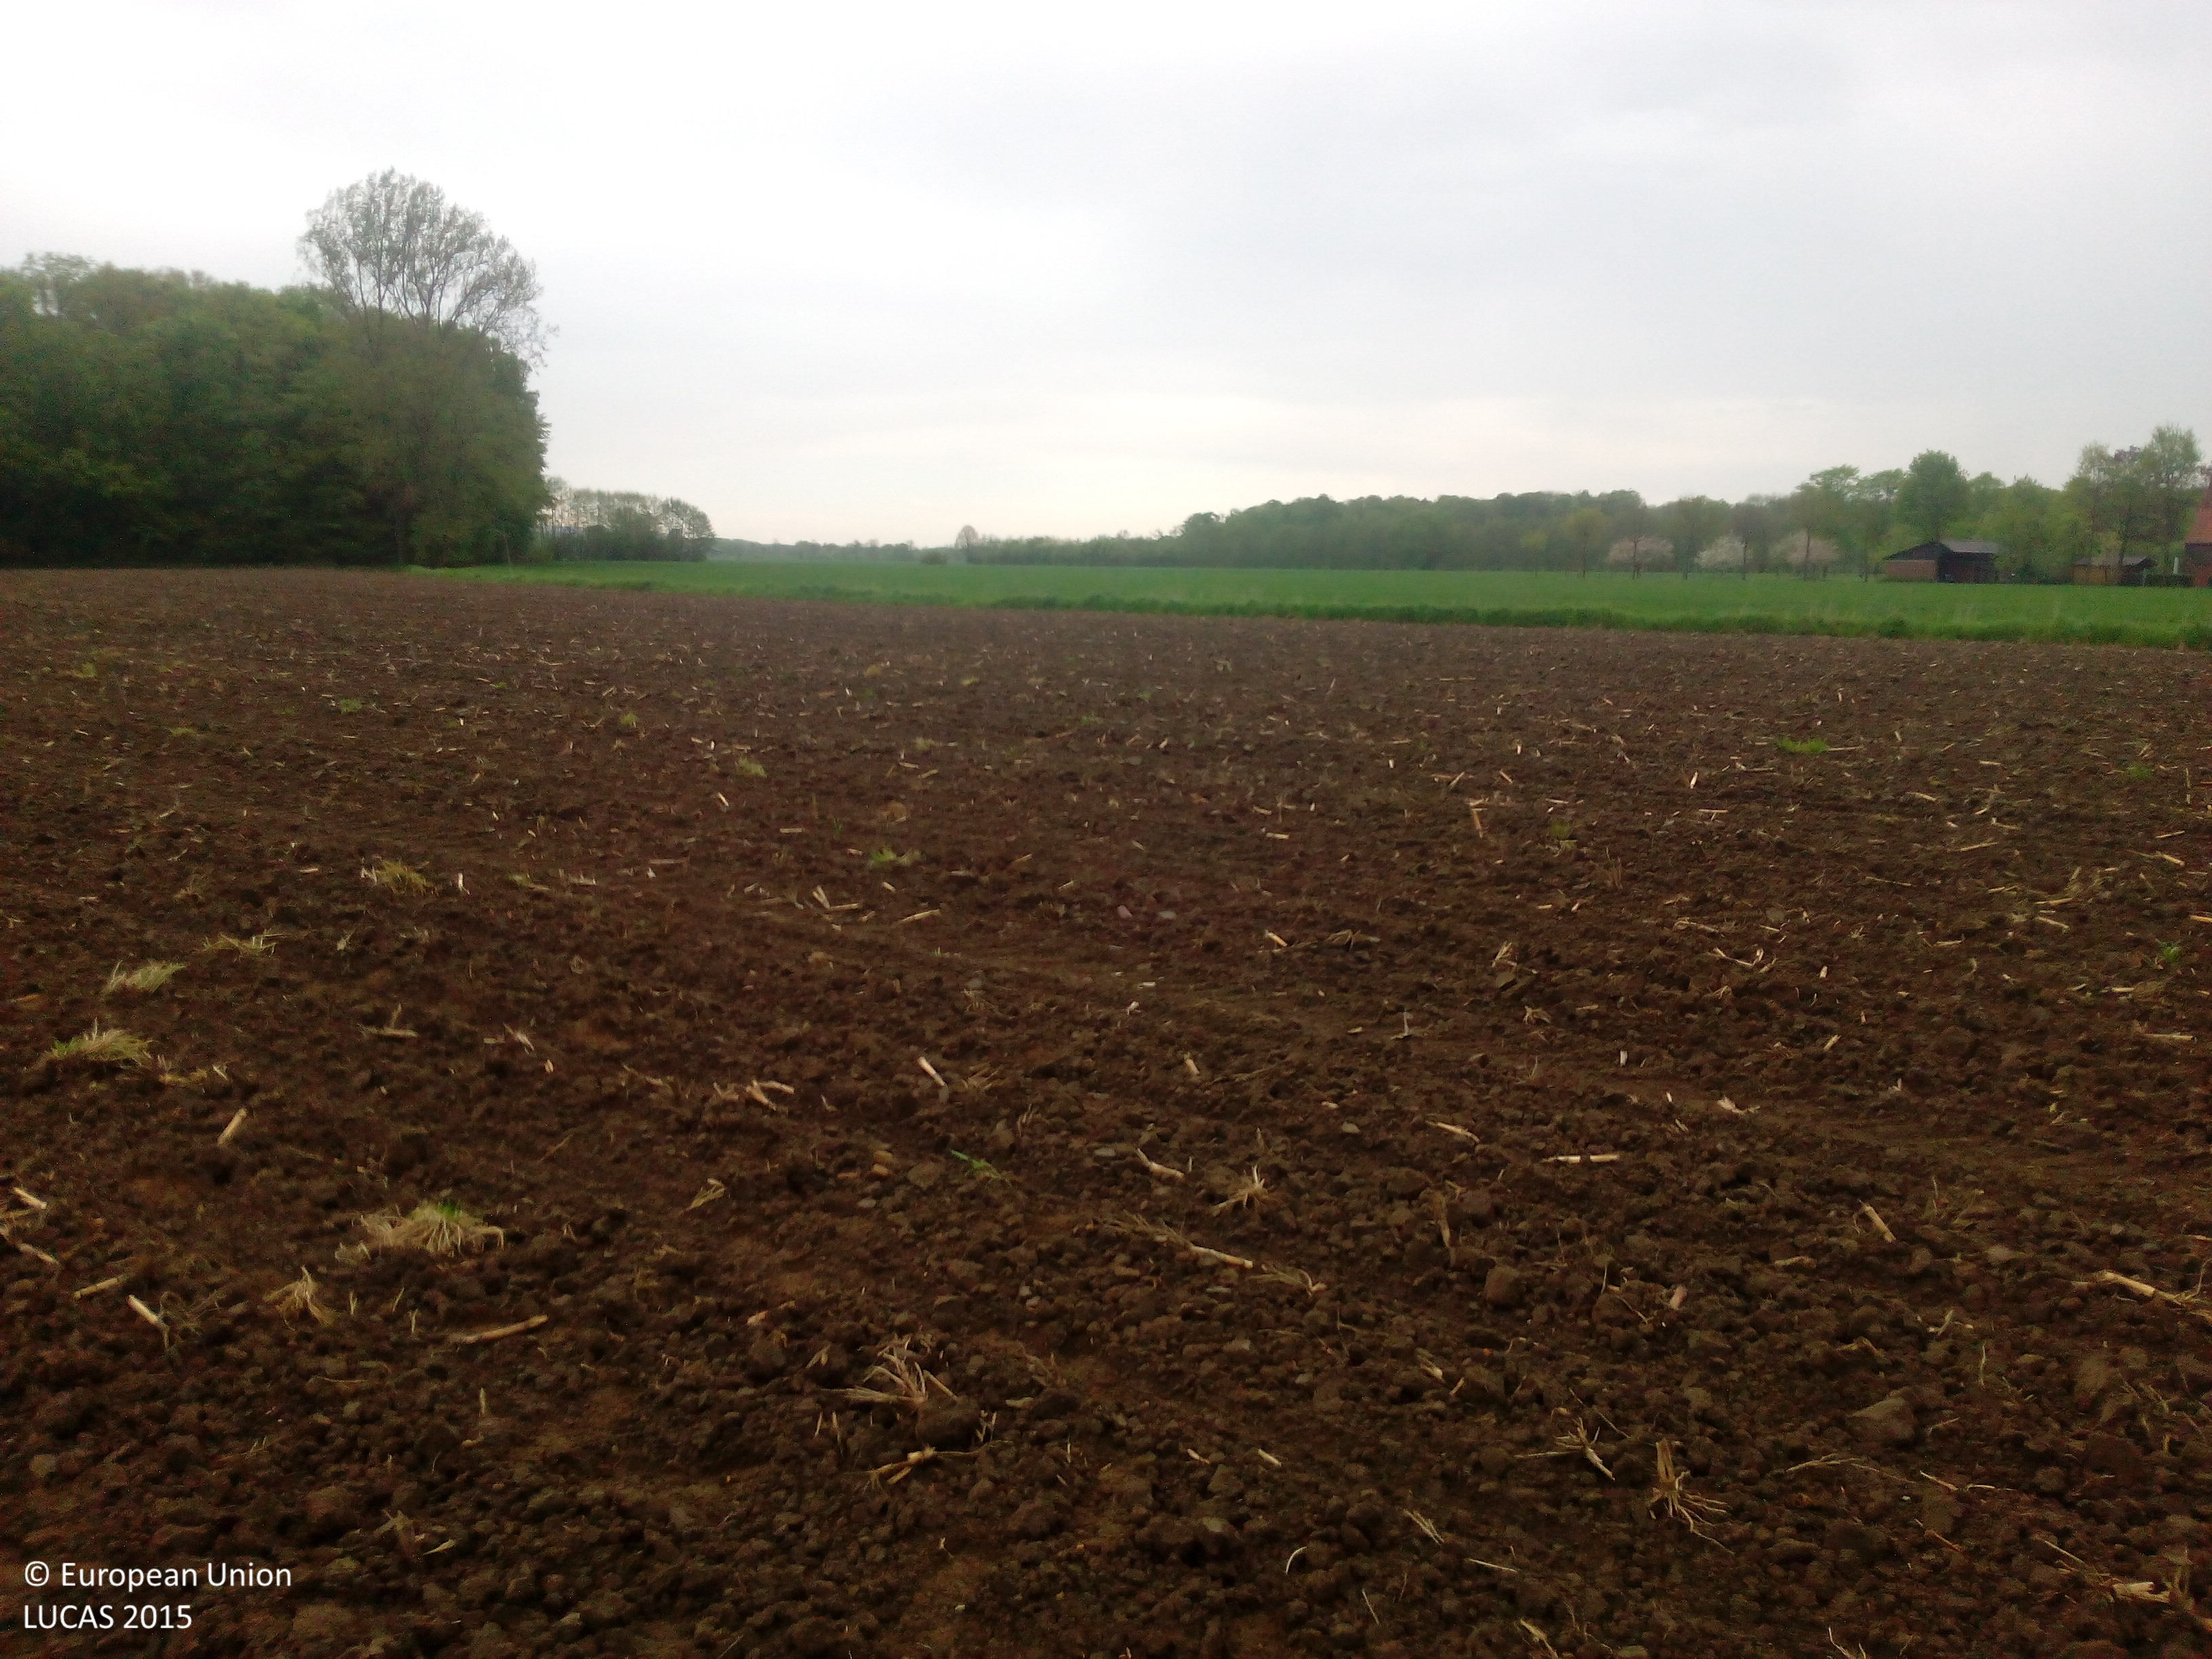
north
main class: Cropland
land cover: Maize
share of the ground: < 10 %
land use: Agriculture (excluding fallow land and kitchen gardens)
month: May
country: DE
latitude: 51.8648
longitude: 7.4589
